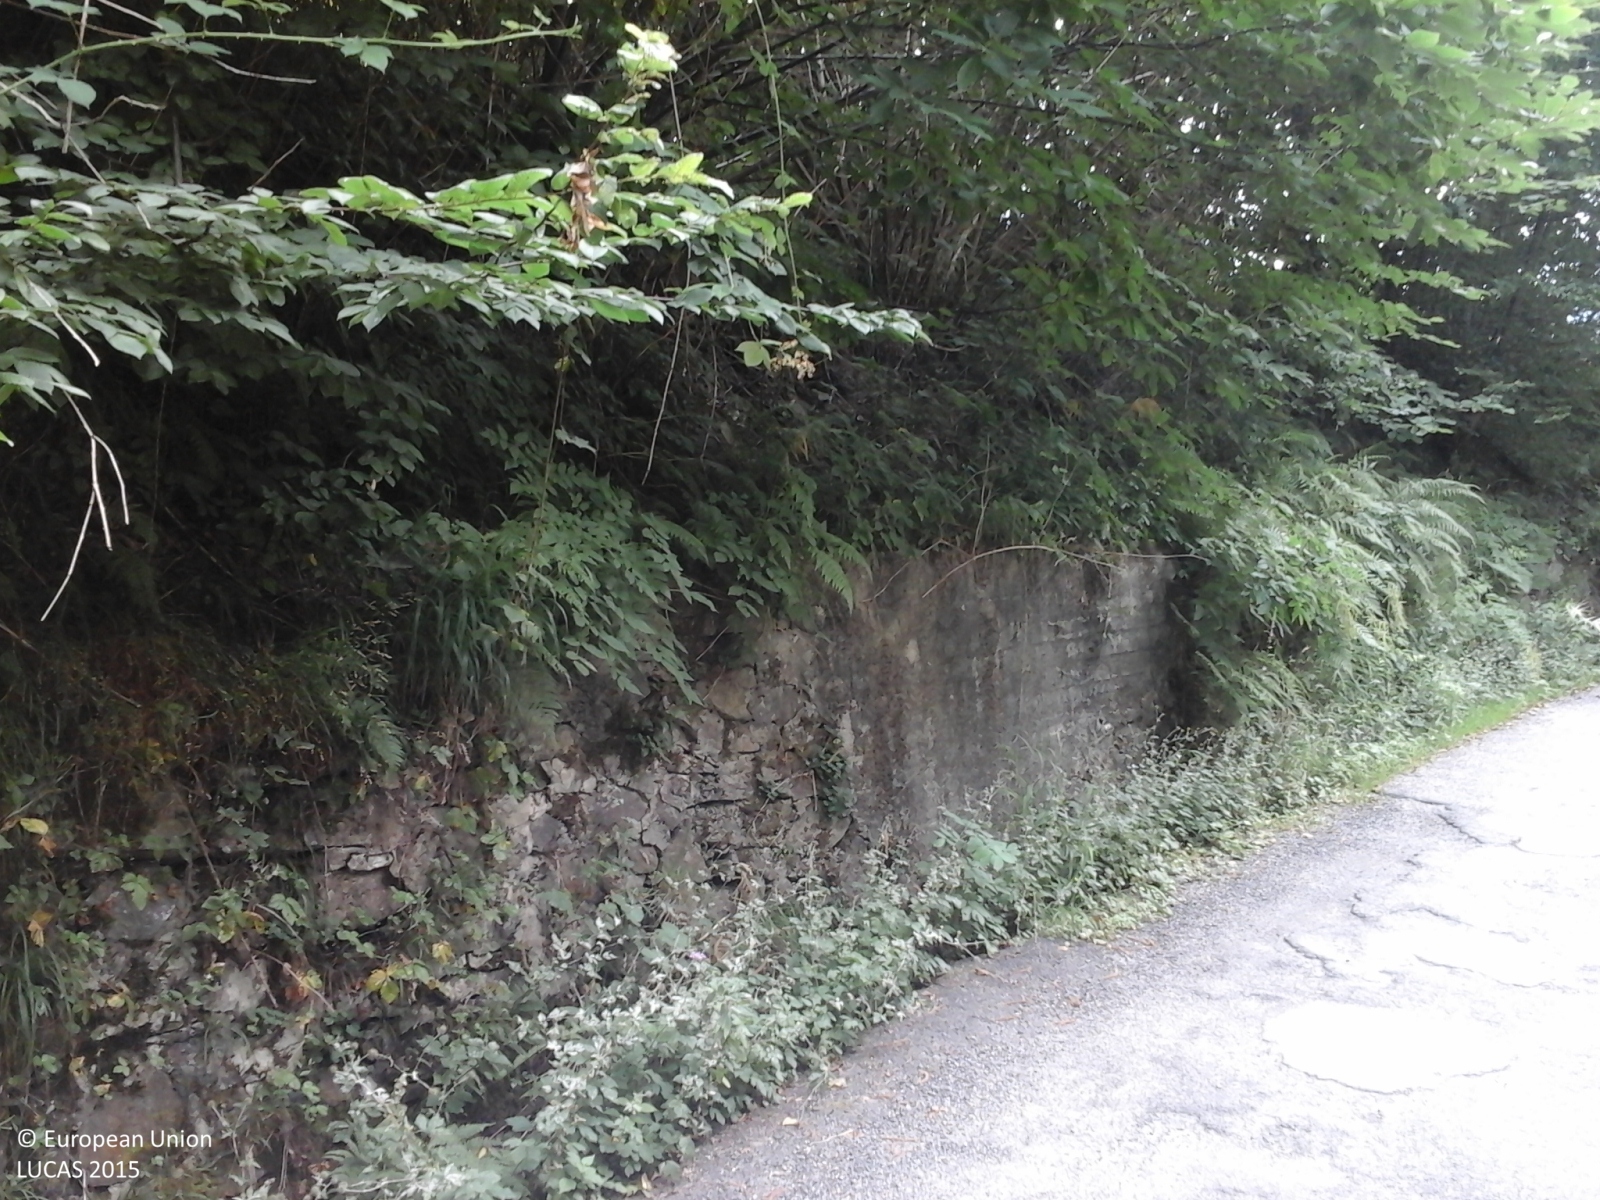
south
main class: Woodland
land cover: Broadleaved woodland
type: beech forest
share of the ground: > 75 %
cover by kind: broadleaved forest trees 100 %
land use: Semi-natural and natural areas not in use
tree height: > 5 m
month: July
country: IT
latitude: 44.9097
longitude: 7.2563
